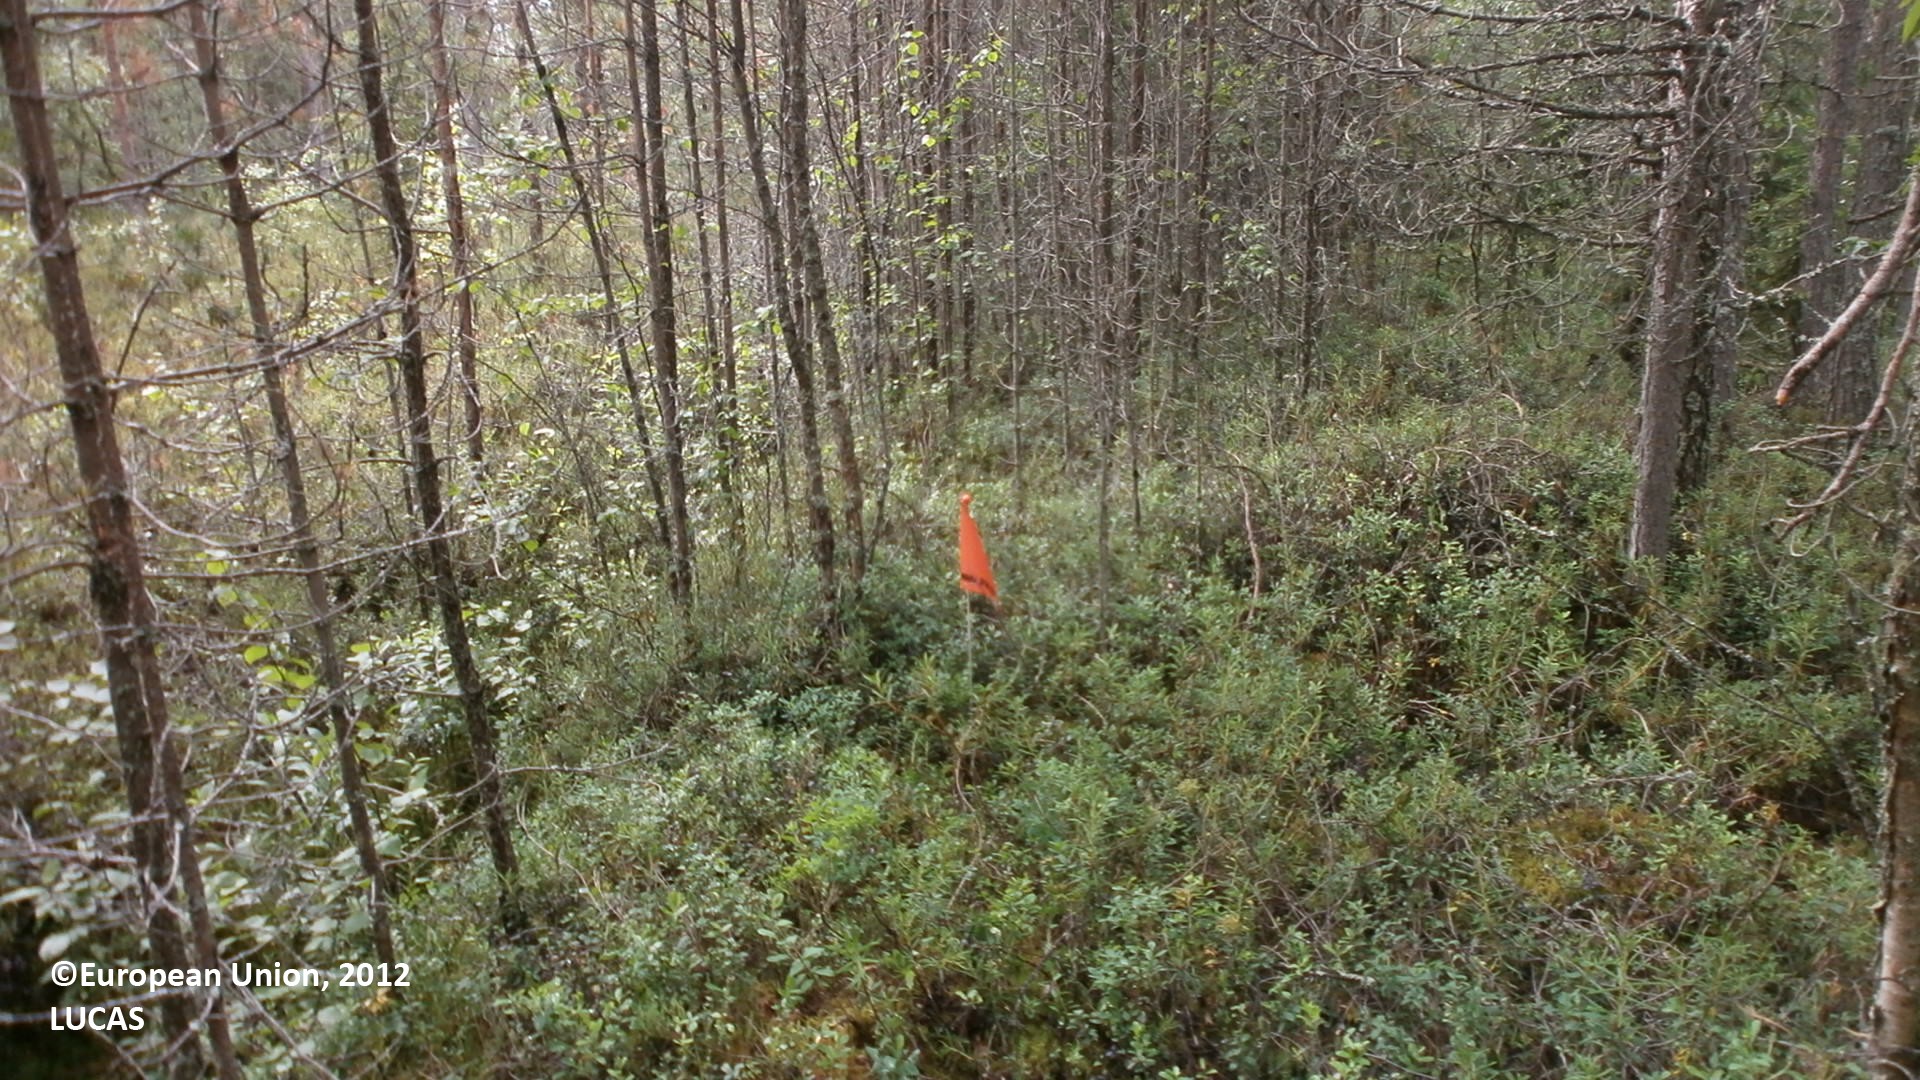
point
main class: Woodland
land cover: Pine dominated coniferous woodland
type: boreal forest
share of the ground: 50 - 75 %
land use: Forestry
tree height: > 5 m
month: July
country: FI
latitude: 64.5657
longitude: 24.4033
